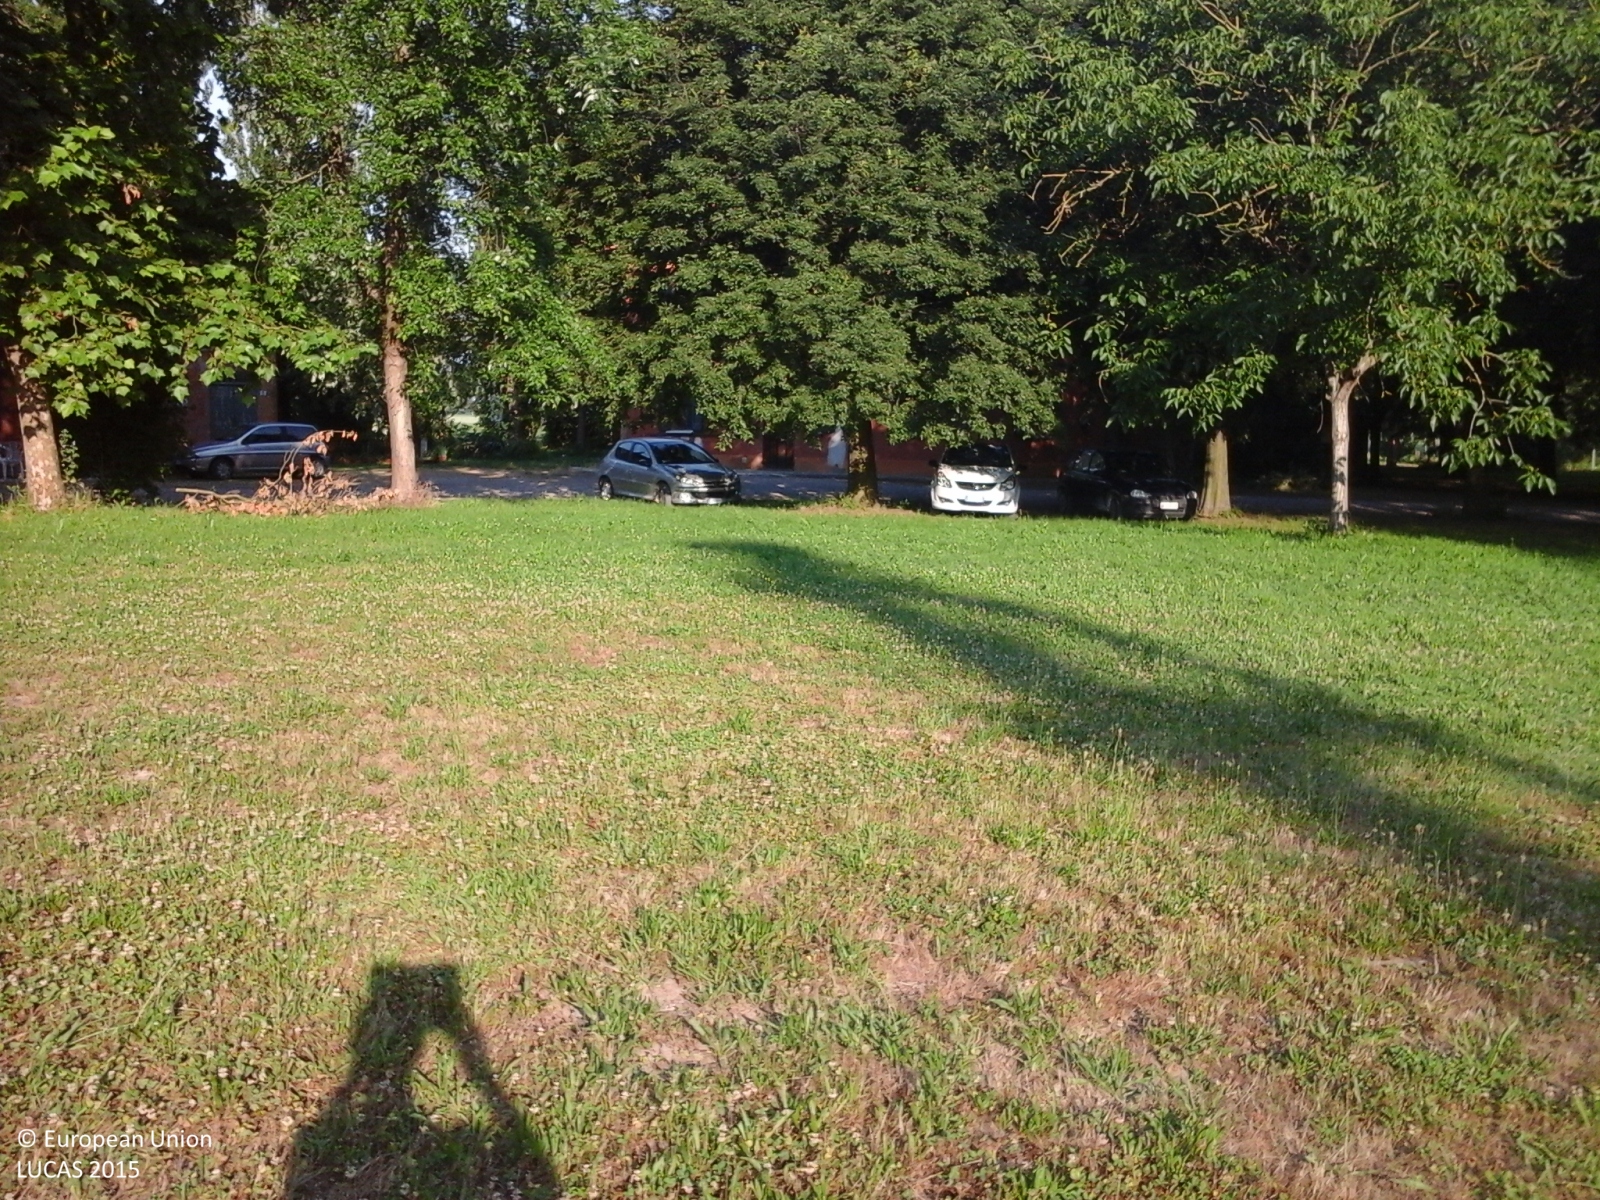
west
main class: Grassland
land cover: Grassland without tree/shrub cover
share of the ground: > 75 %
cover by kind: herbaceous plants 100 %
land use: Agriculture (excluding fallow land and kitchen gardens)
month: June
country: IT
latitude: 44.6073
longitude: 11.6975
